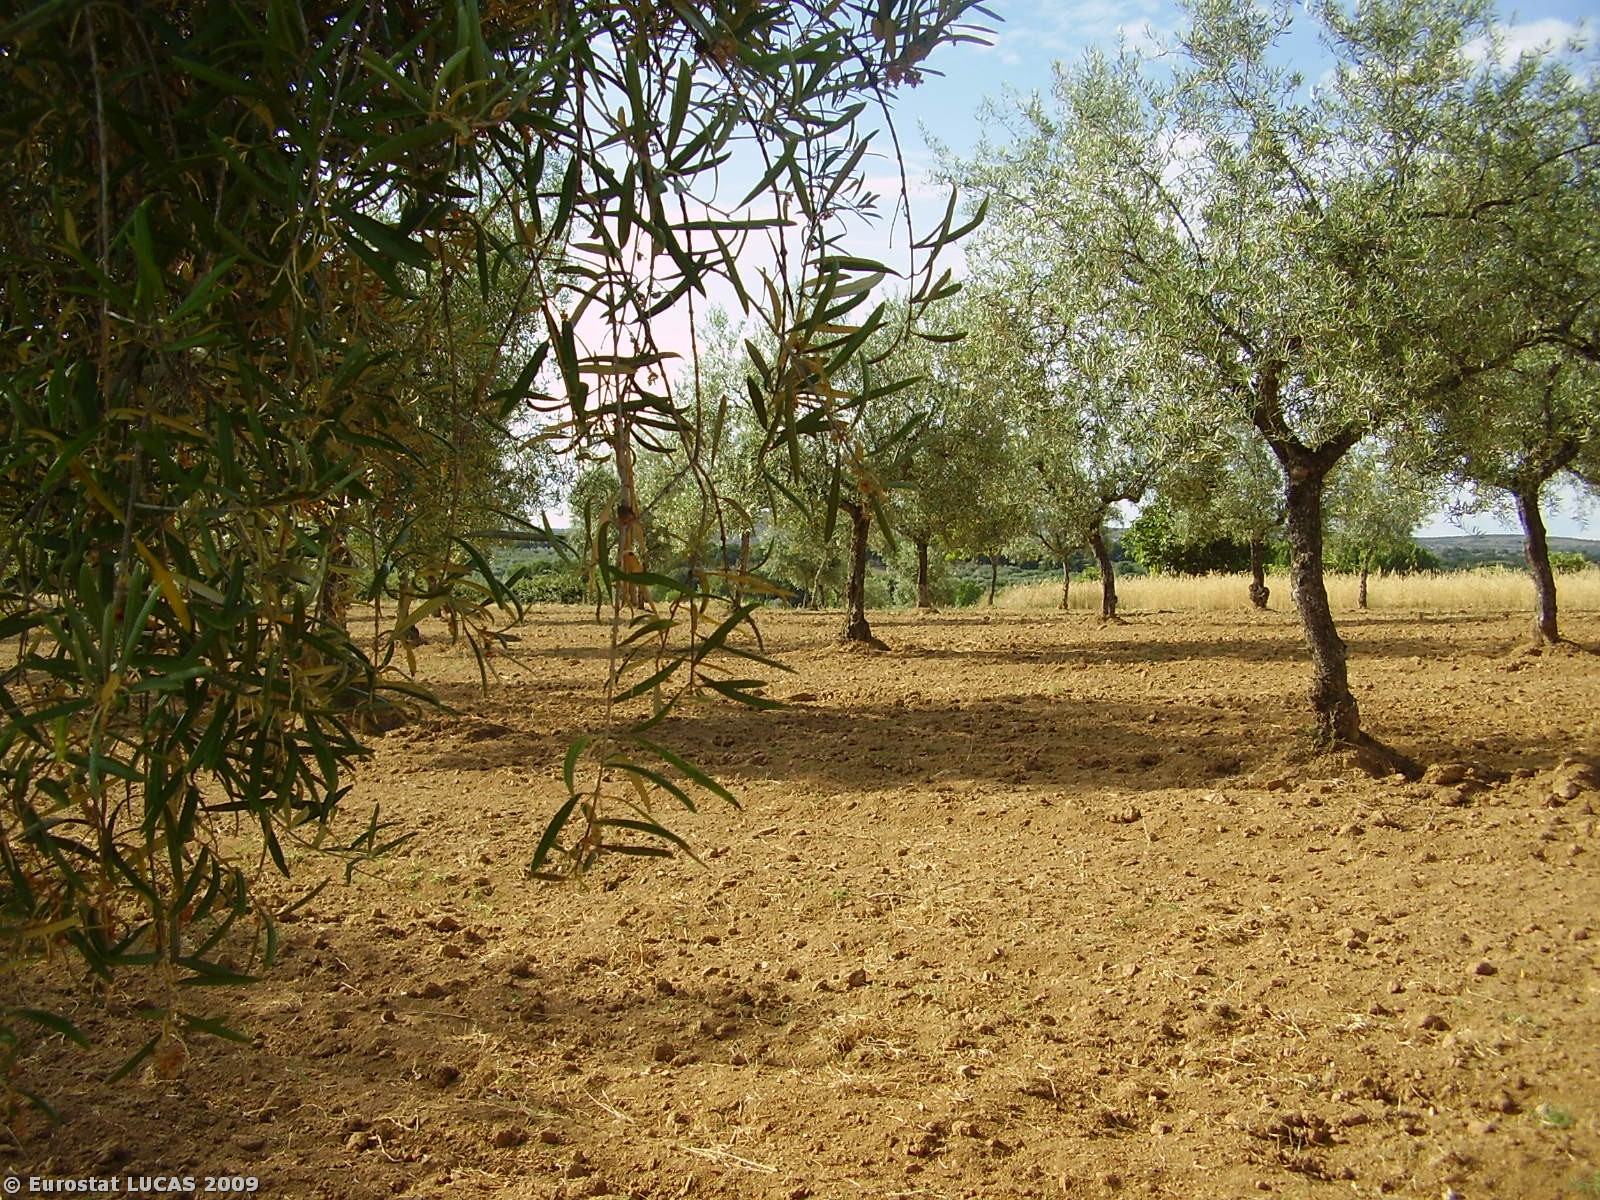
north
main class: Cropland
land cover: Olive groves
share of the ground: 25 - 50 %
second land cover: Bare land
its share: 50 - 75 %
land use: Agriculture (excluding fallow land and kitchen gardens)
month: June
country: PT
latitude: 41.4662
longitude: -6.7631
